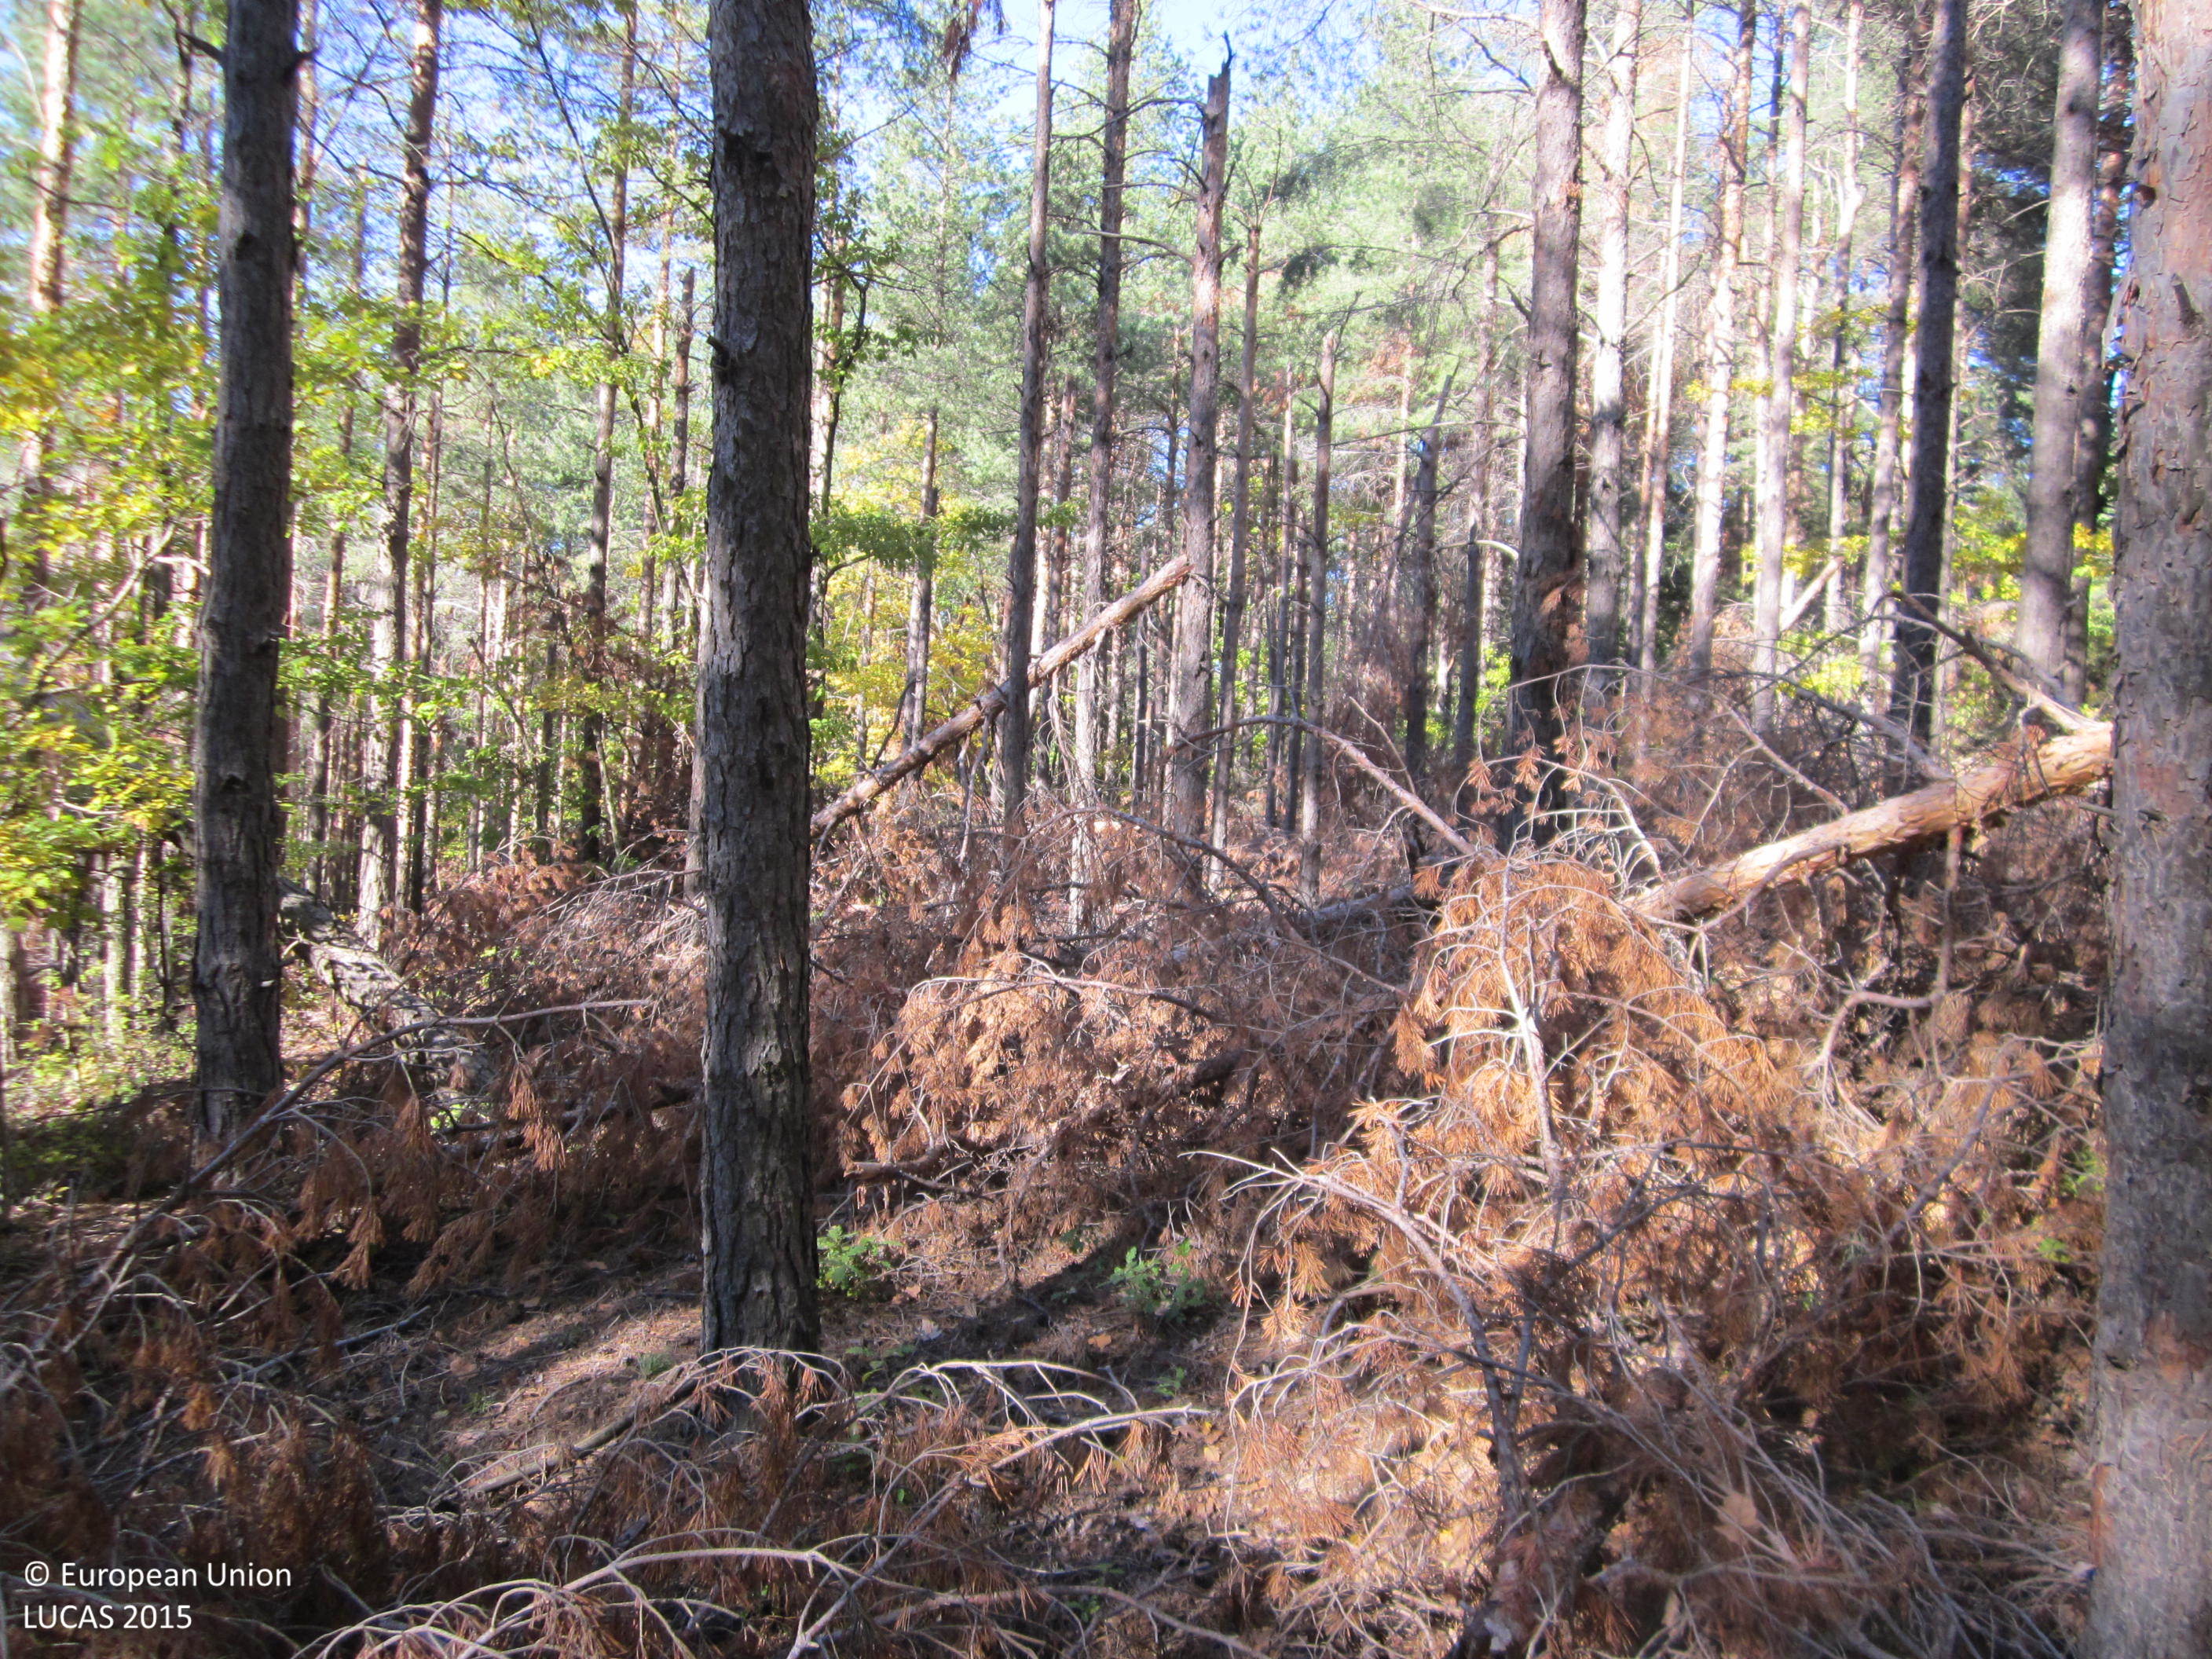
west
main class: Woodland
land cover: Pine dominated coniferous woodland
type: hemiboreal forest and nemoral coniferous forest and mixed broadleaved-coniferous forest
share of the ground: > 75 %
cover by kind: coniferous forest trees 70 %, unconsolidated bare surface 15 %, broadleaved forest trees 10 %, shrubs 5 %
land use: Forestry
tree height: > 5 m
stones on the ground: < 10 %
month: November
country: BG
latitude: 41.3921
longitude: 25.7644
